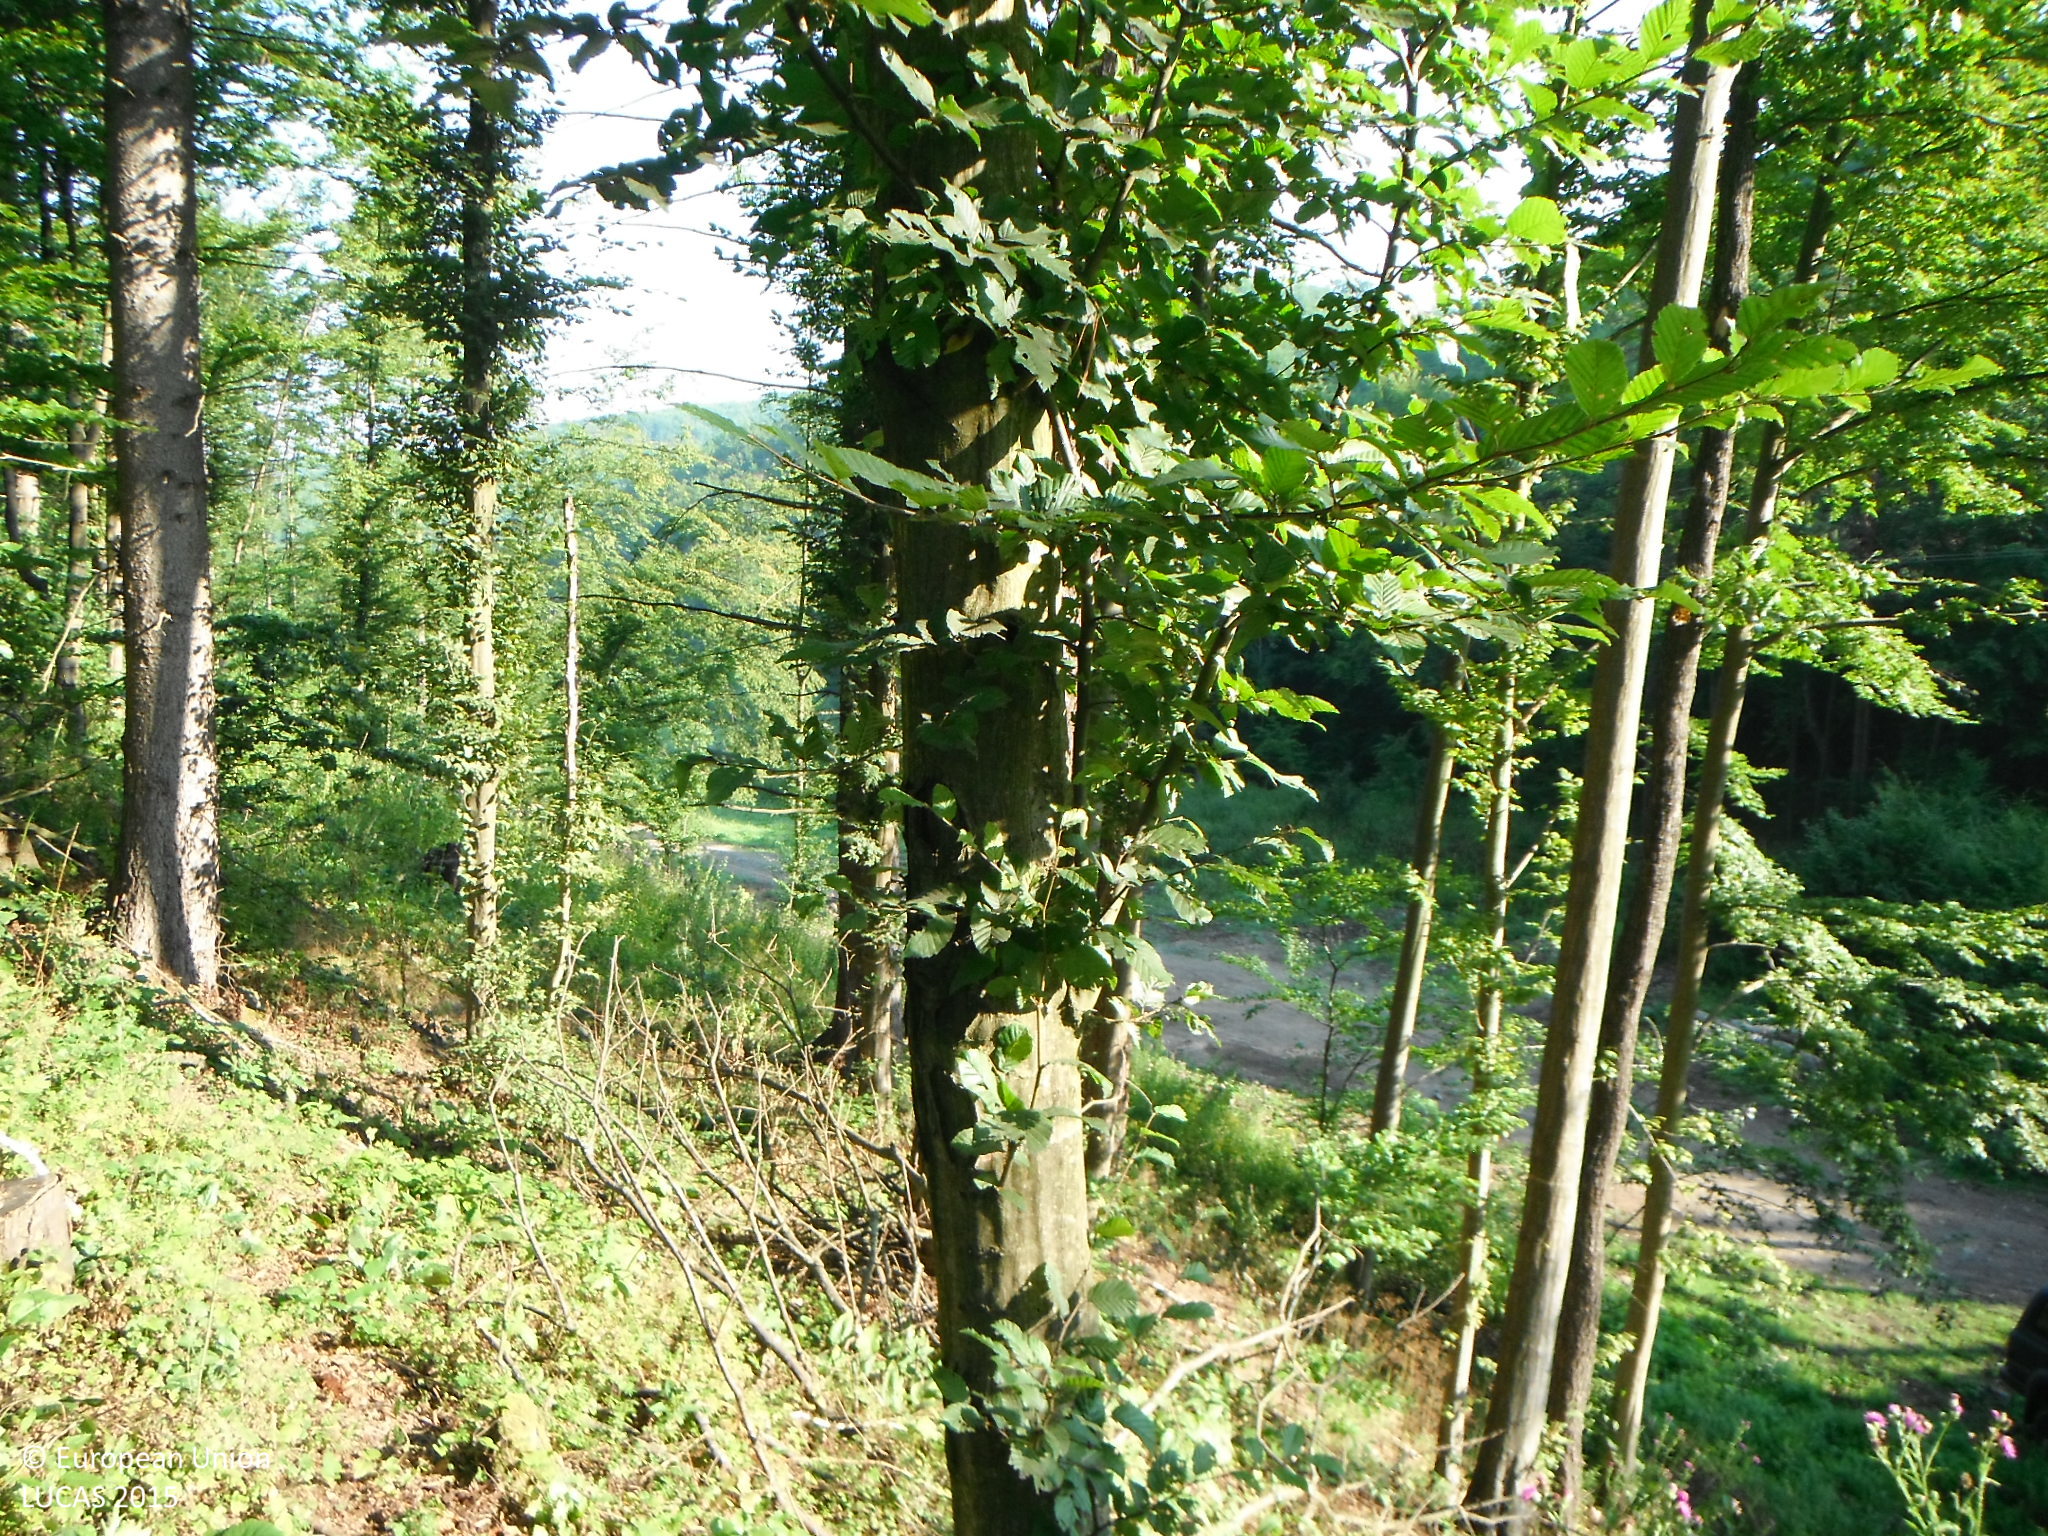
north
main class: Woodland
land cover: Broadleaved woodland
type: mountainous beech forest
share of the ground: 50 - 75 %
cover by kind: broadleaved forest trees 90 %, coniferous forest trees 5 %, herbaceous plants 5 %
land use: Forestry
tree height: > 5 m
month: August
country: SK
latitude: 48.3978
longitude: 19.2201
